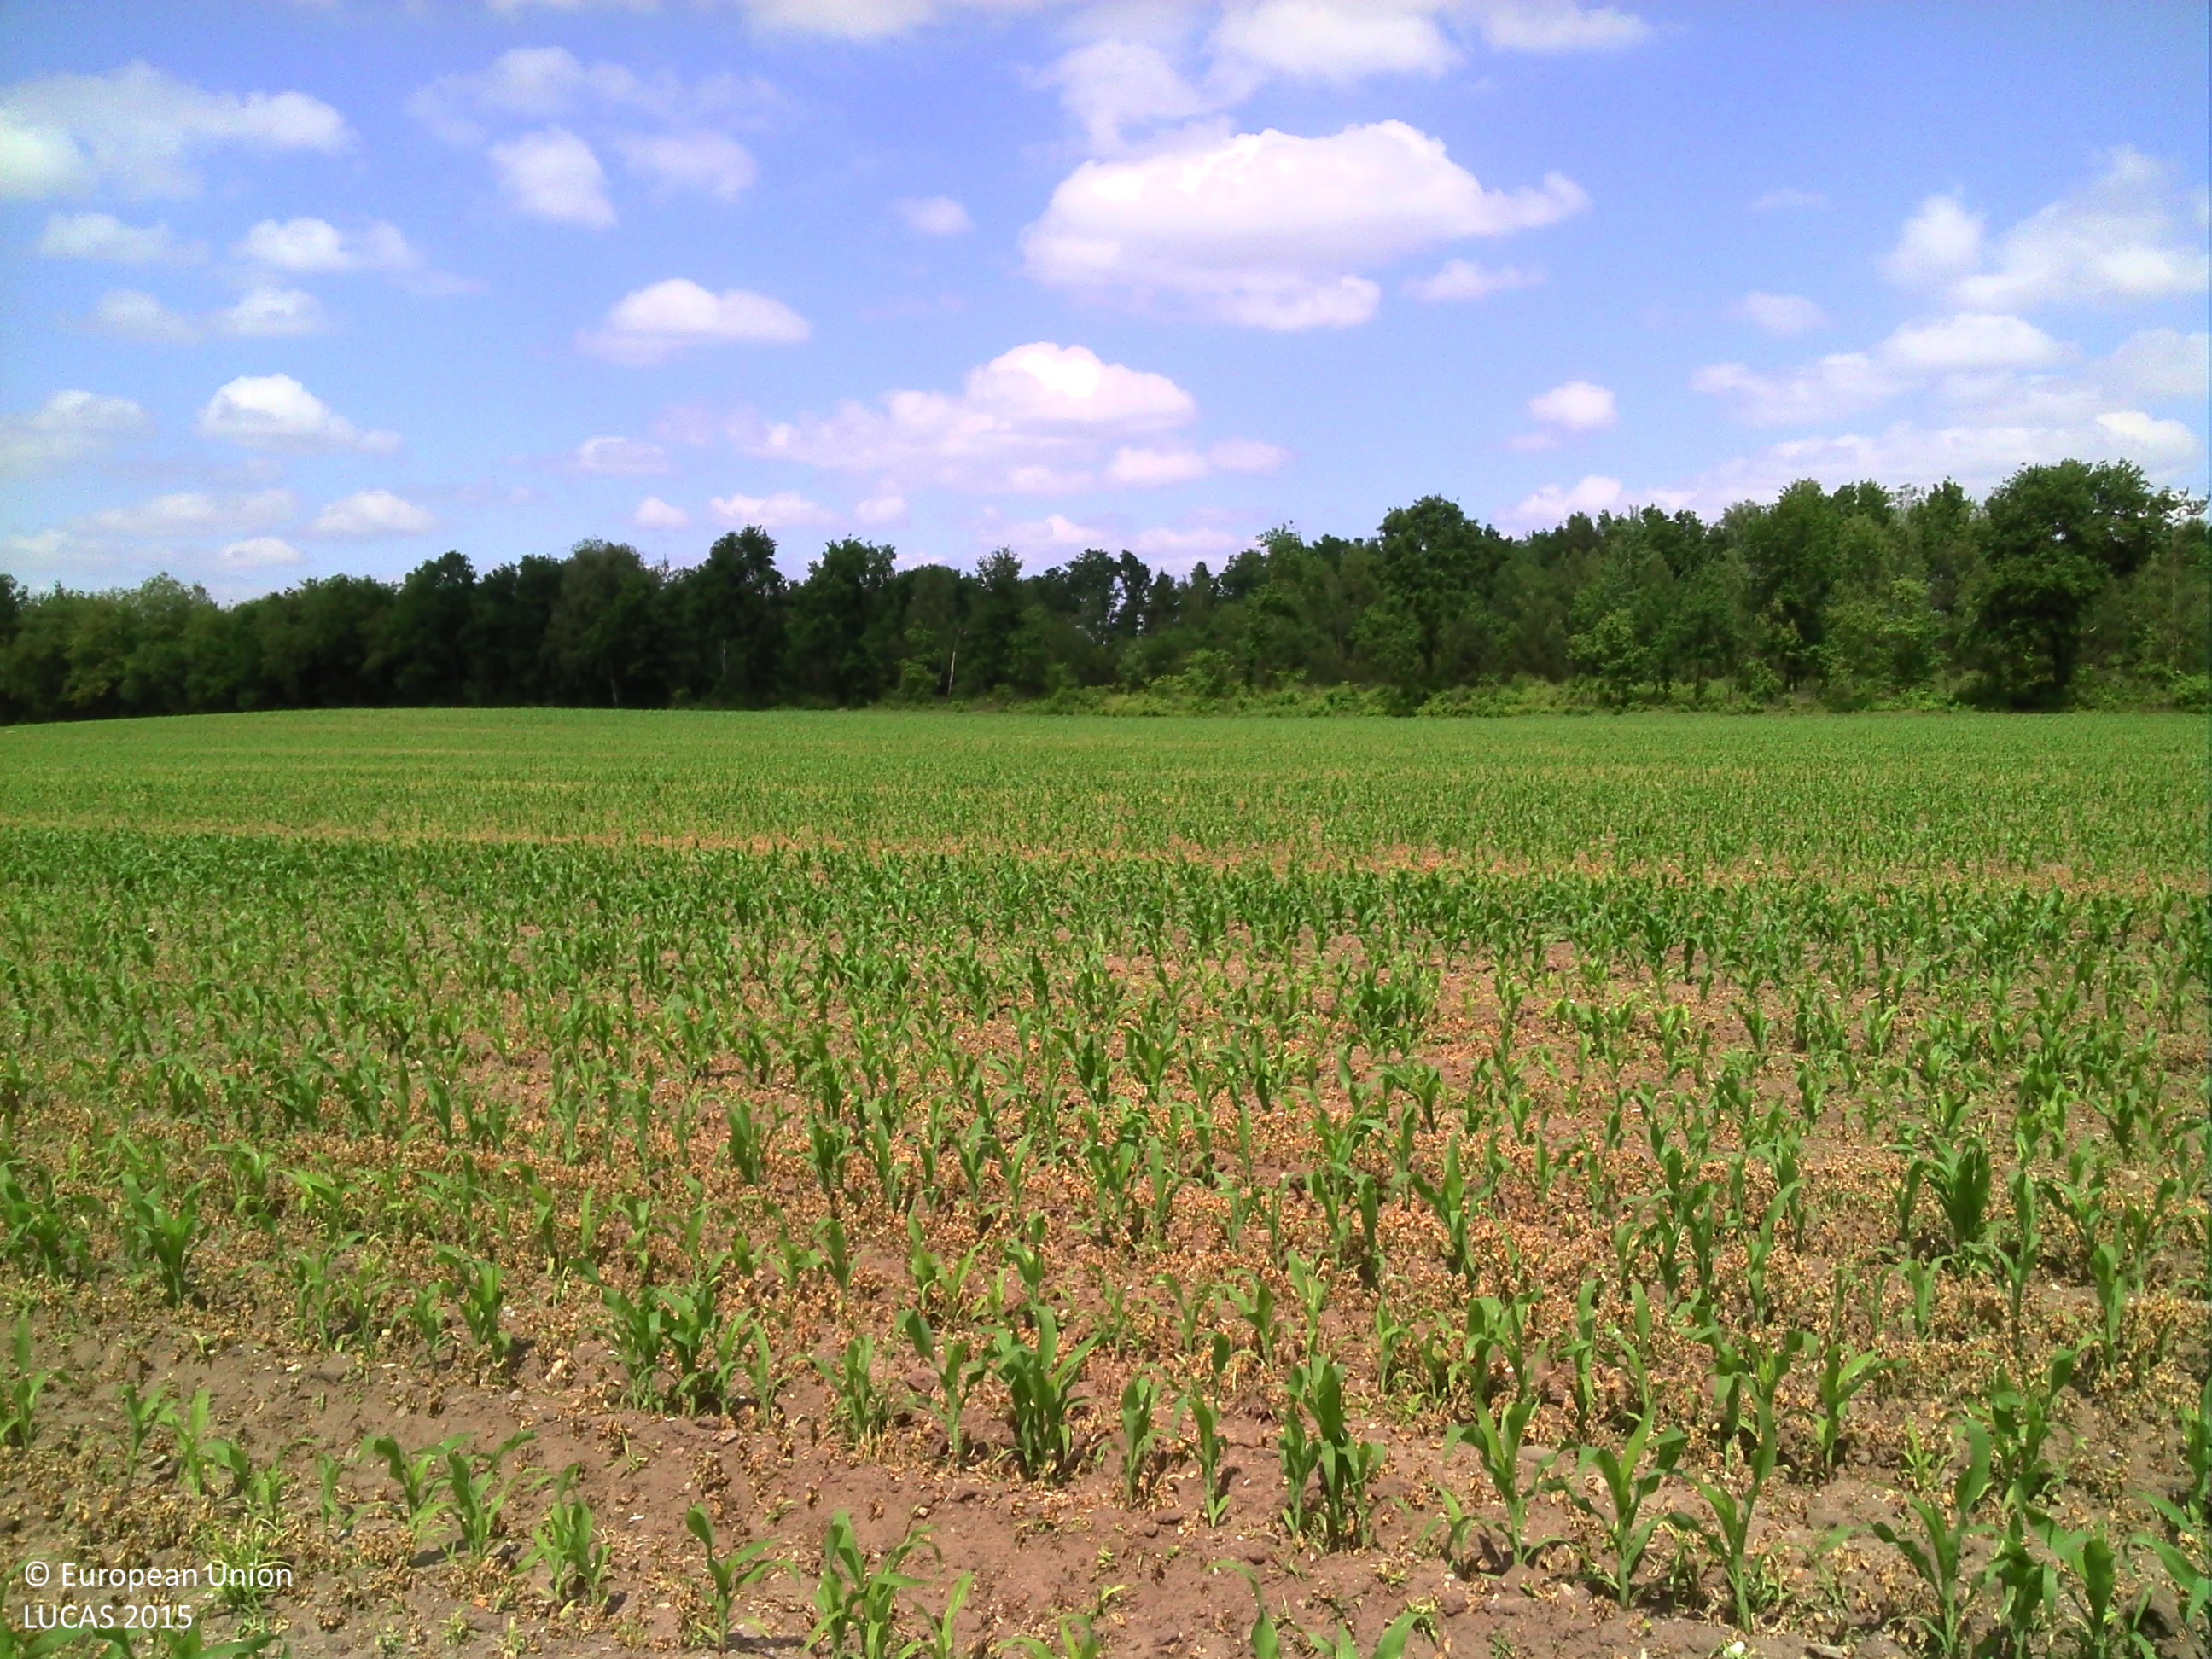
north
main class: Cropland
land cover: Maize
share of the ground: 10 - 25 %
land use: Agriculture (excluding fallow land and kitchen gardens)
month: June
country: BE
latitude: 50.9848
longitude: 5.6822
